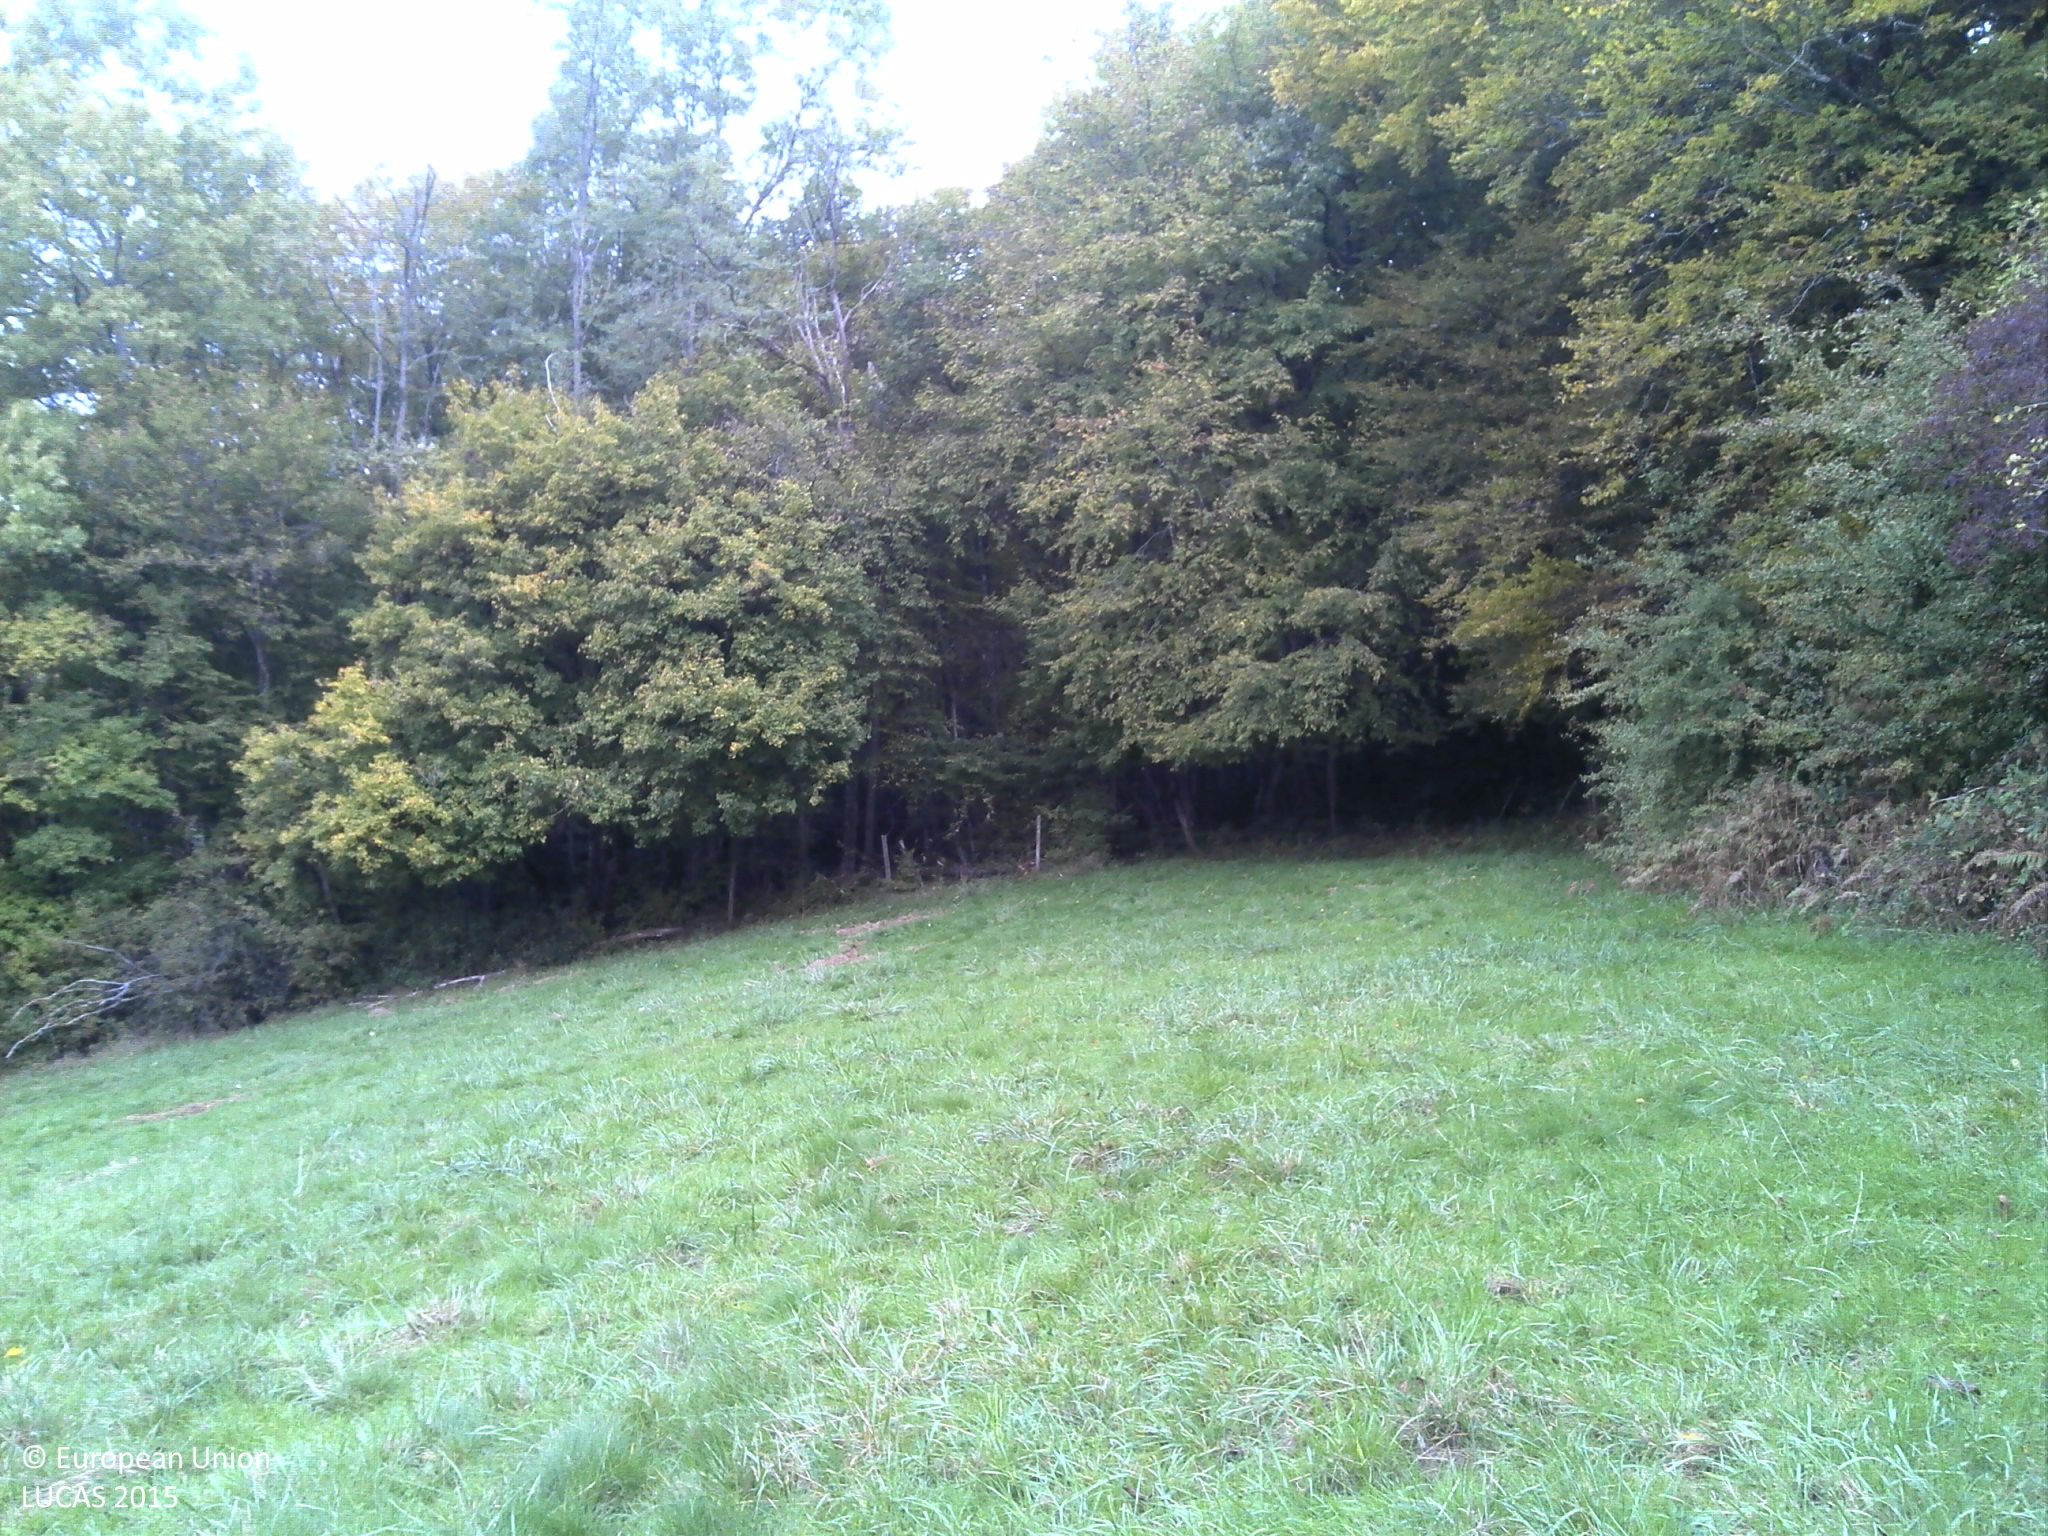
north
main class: Grassland
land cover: Grassland with sparse tree/shrub cover
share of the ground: > 75 %
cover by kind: herbaceous plants 95 %, broadleaved forest trees 5 %
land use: Agriculture (excluding fallow land and kitchen gardens)
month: October
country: FR
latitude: 46.1050
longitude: 5.3330
